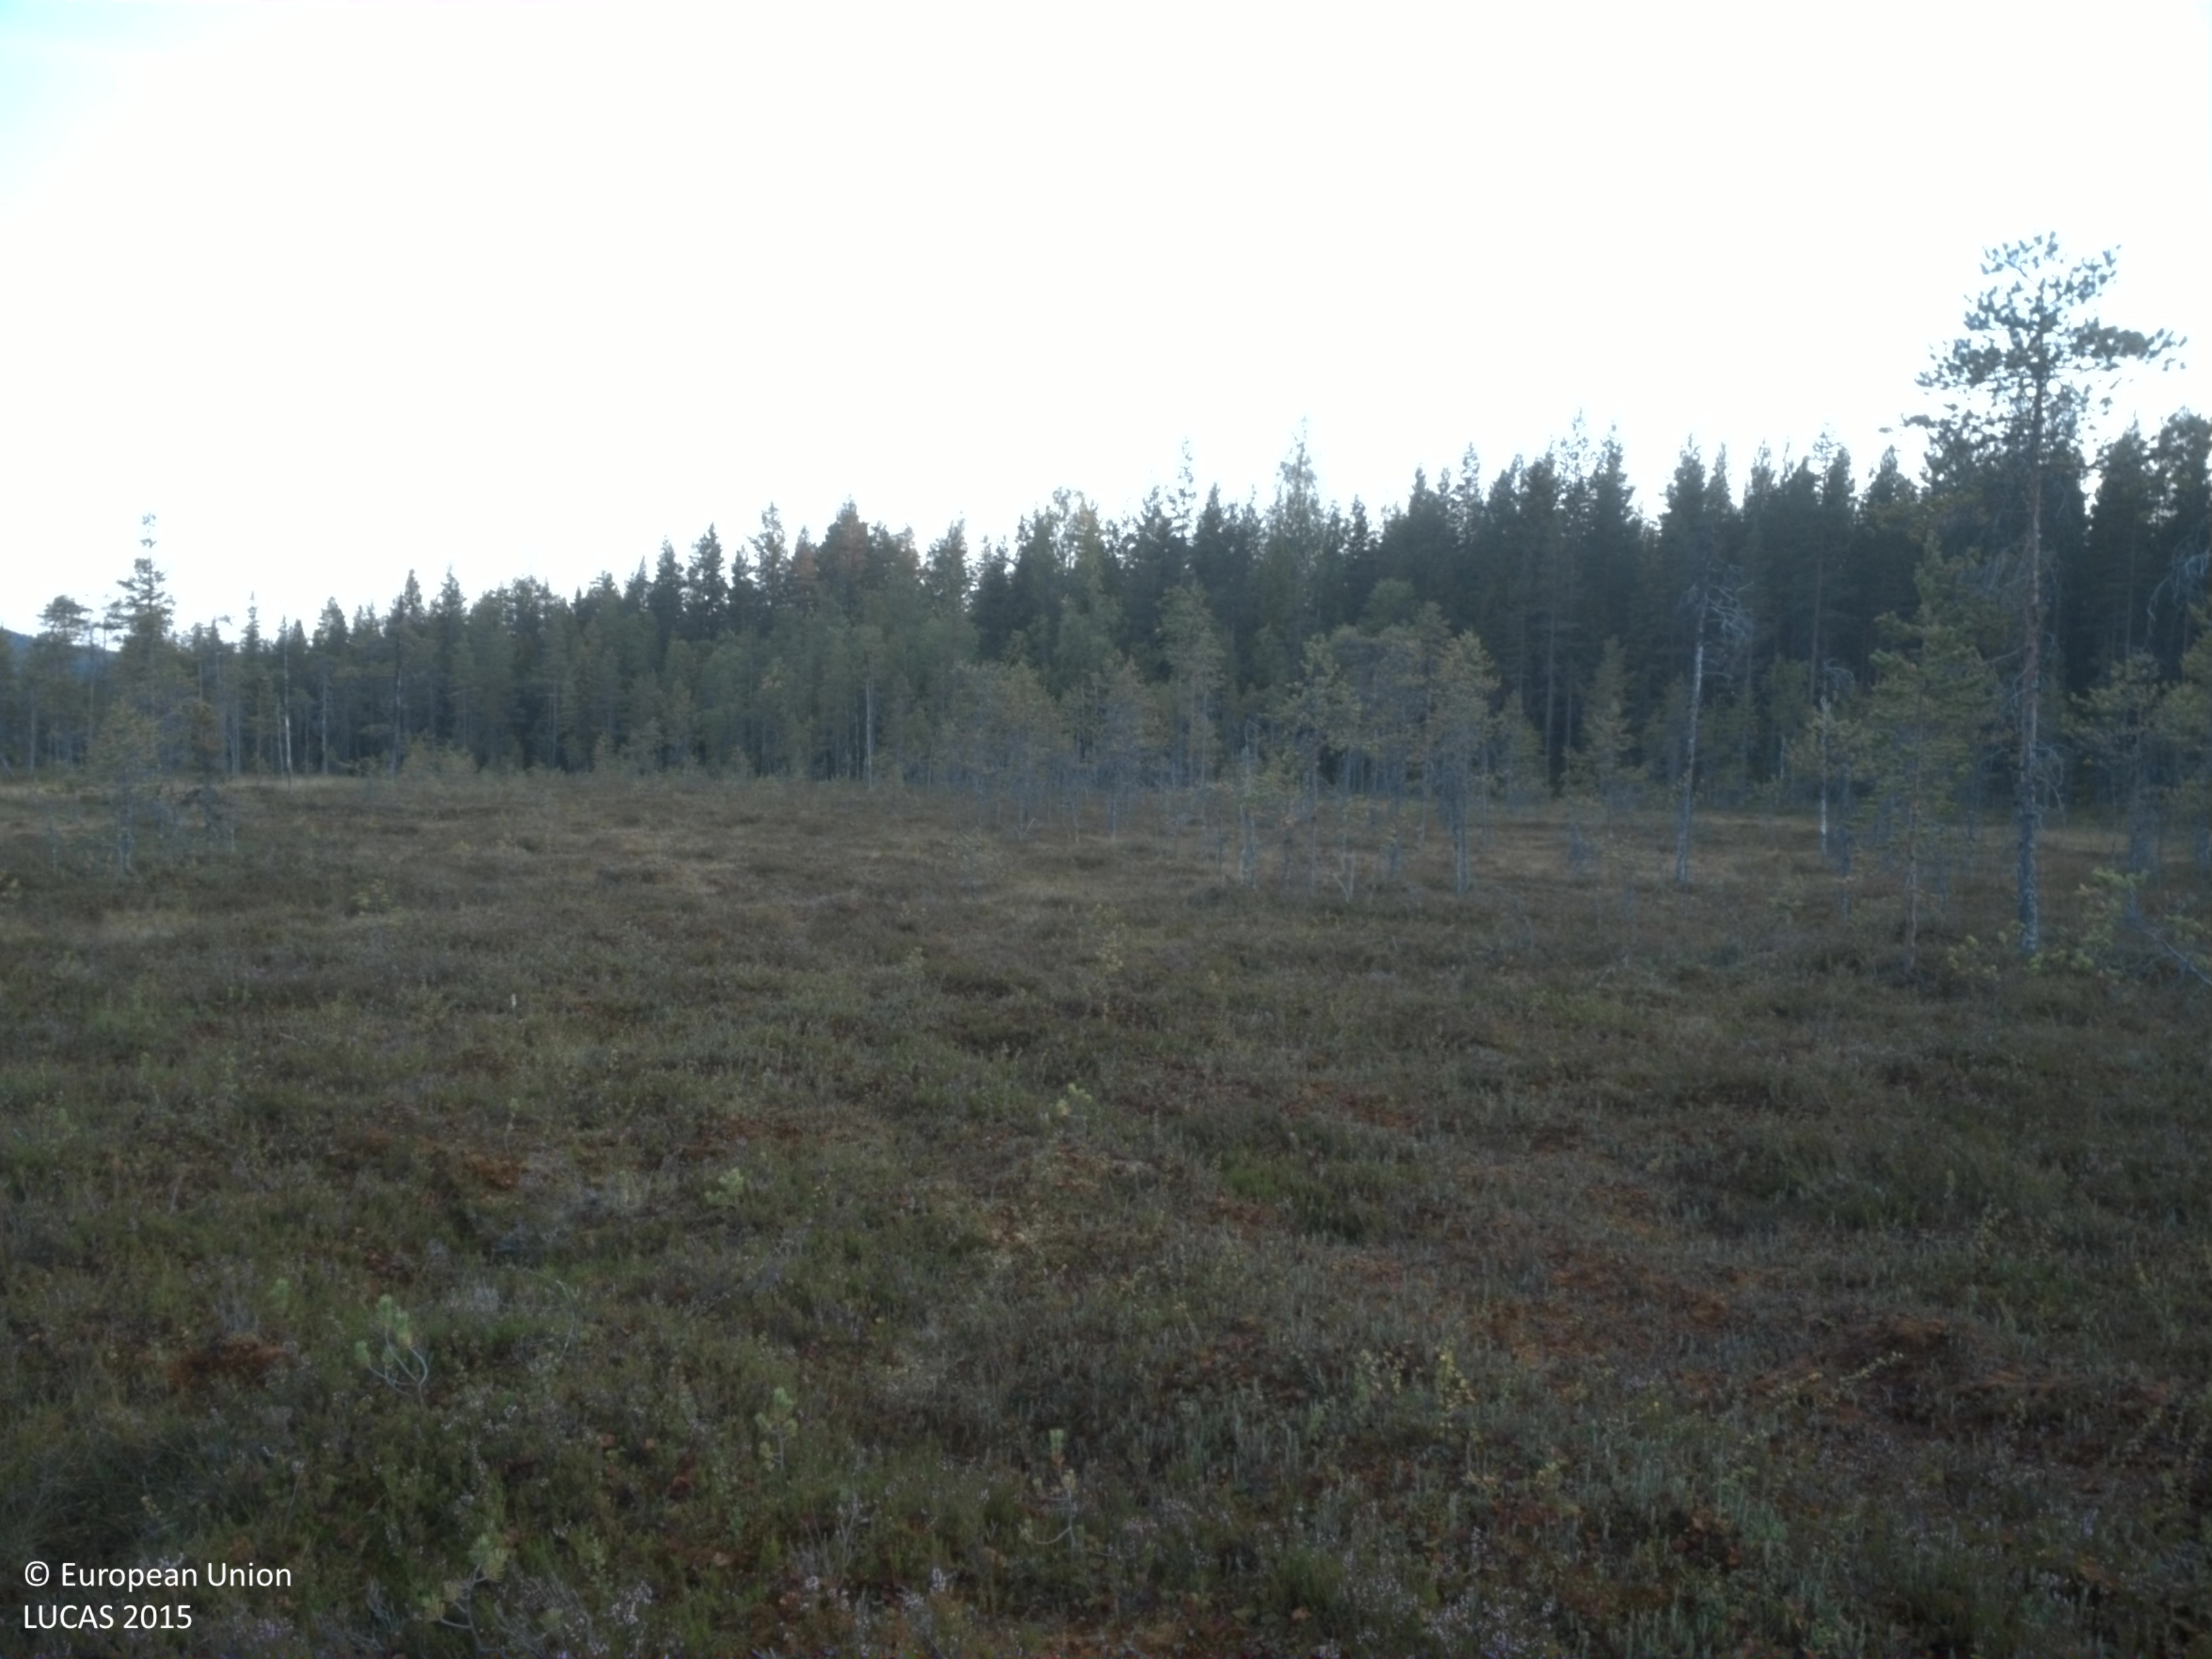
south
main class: Shrubland
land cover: Shrubland with sparse tree cover
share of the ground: > 75 %
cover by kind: shrubs 75 %, herbaceous plants 10 %, lichens and mosses 10 %, coniferous forest trees 5 %
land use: Semi-natural and natural areas not in use
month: August
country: SE
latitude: 64.4891
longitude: 18.9806
